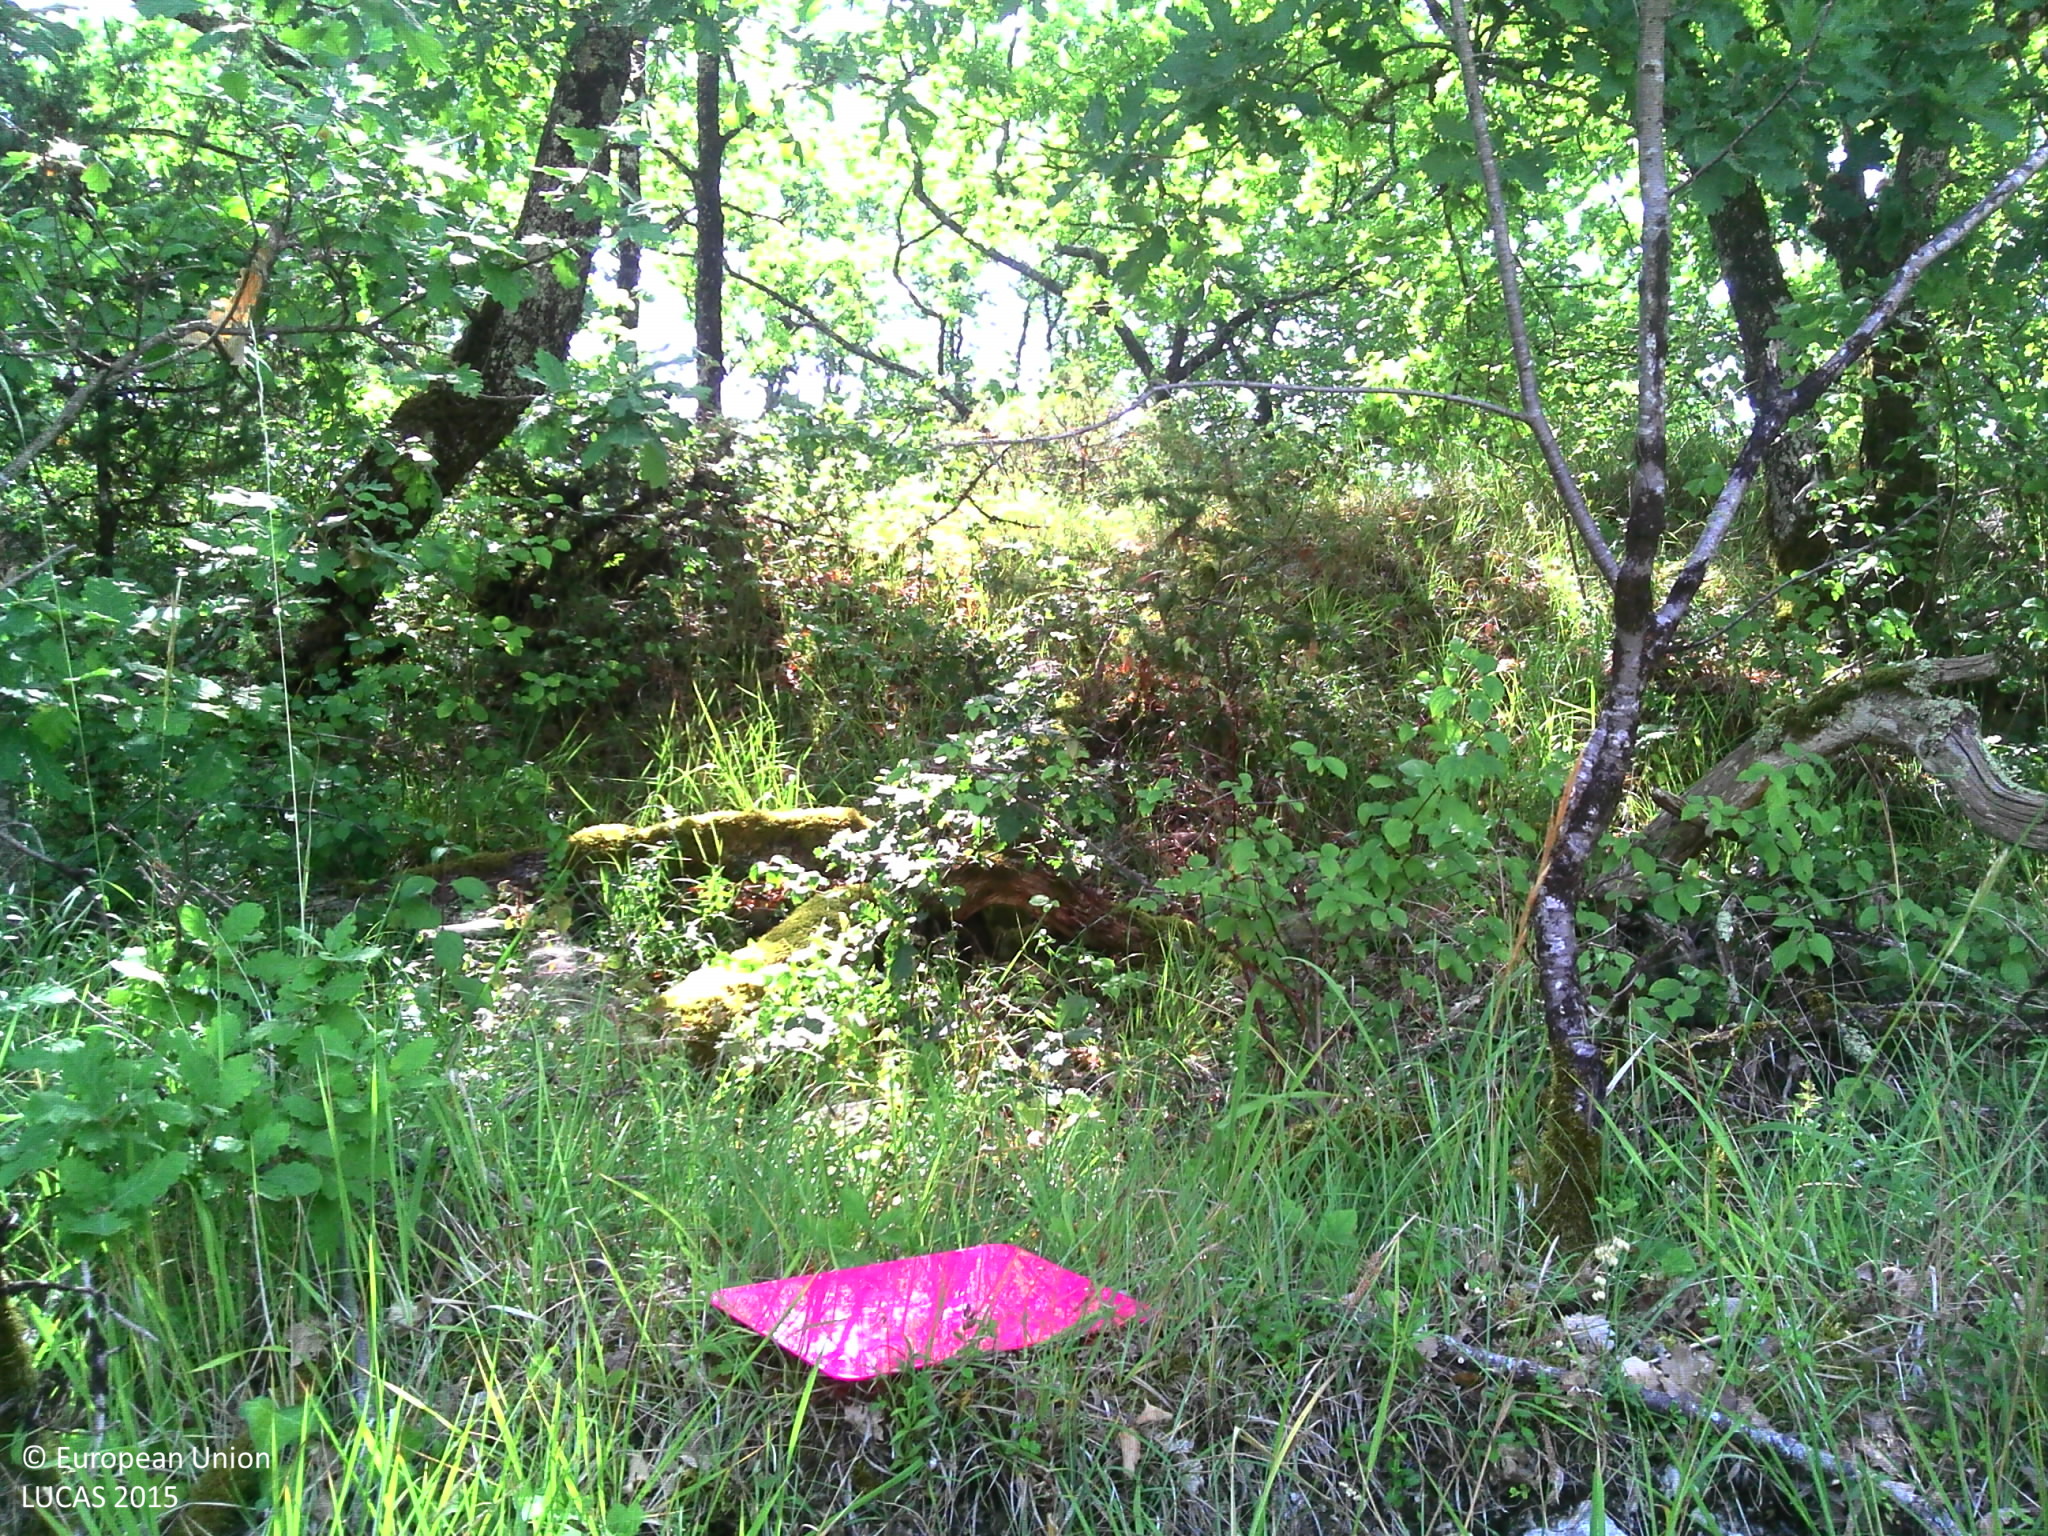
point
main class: Woodland
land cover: Broadleaved woodland
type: mesophytic deciduous forest
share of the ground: > 75 %
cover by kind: broadleaved forest trees 100 %
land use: Forestry
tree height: > 5 m
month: July
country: FR
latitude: 44.3622
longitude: 1.0501
